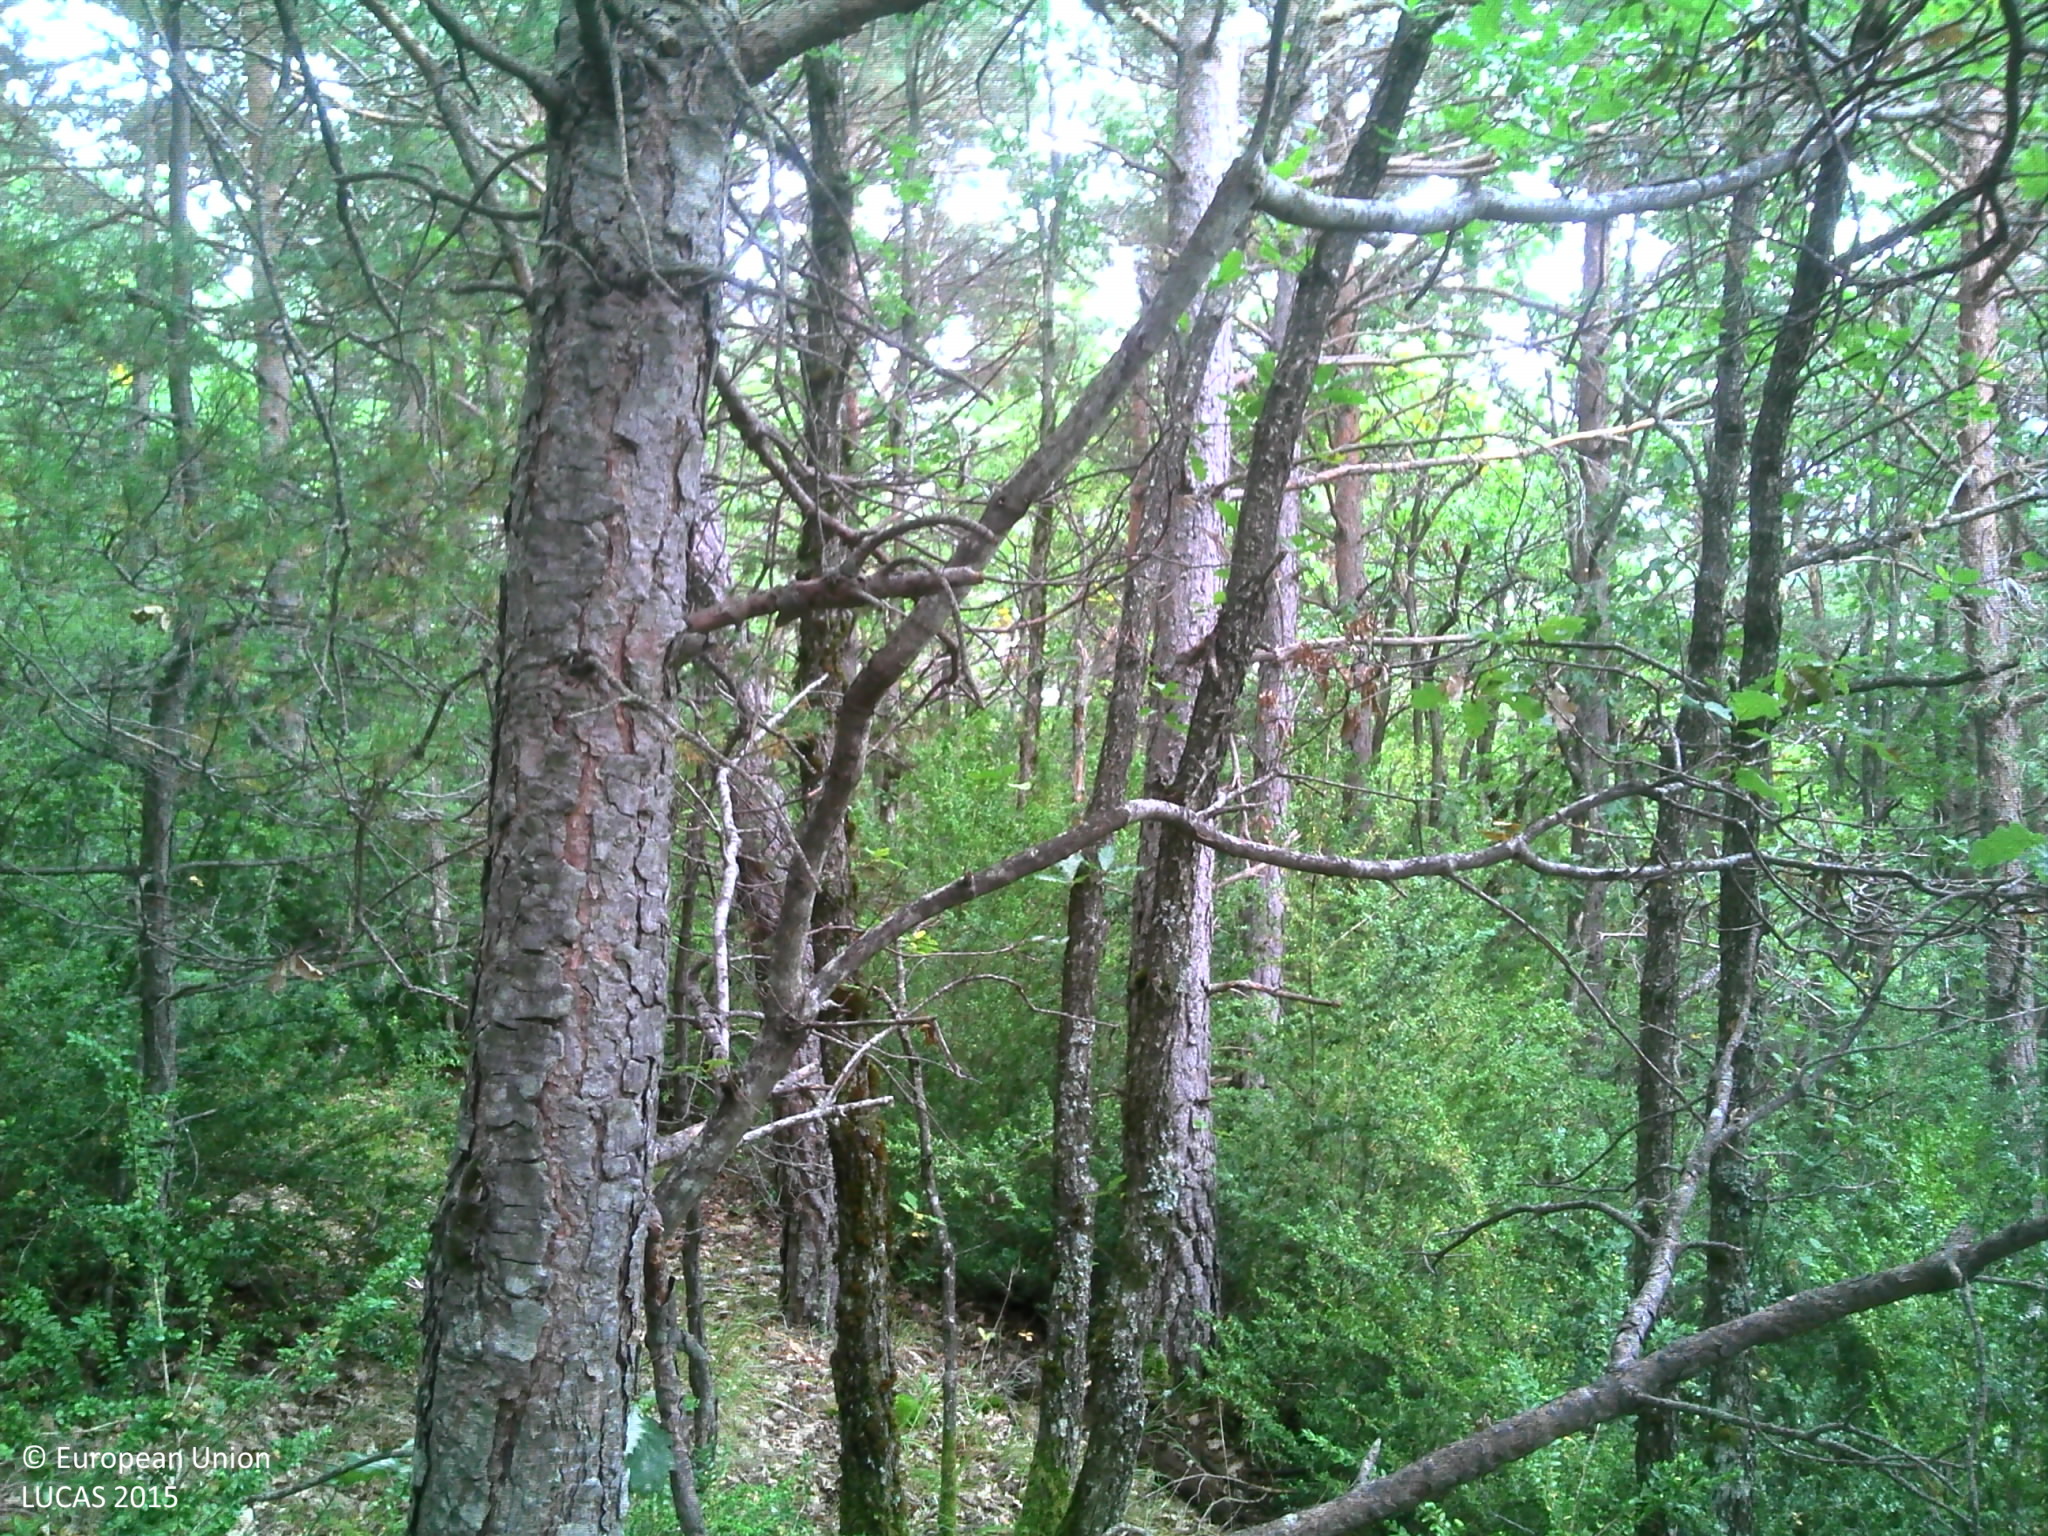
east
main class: Woodland
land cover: Pine dominated mixed woodland
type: alpine coniferous forest
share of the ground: > 75 %
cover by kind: broadleaved forest trees 50 %, coniferous forest trees 20 %, shrubs 20 %, herbaceous plants 10 %
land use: Forestry
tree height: > 5 m
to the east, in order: Pine dominated mixed woodland
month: September
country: FR
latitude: 44.5987
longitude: 5.5596
